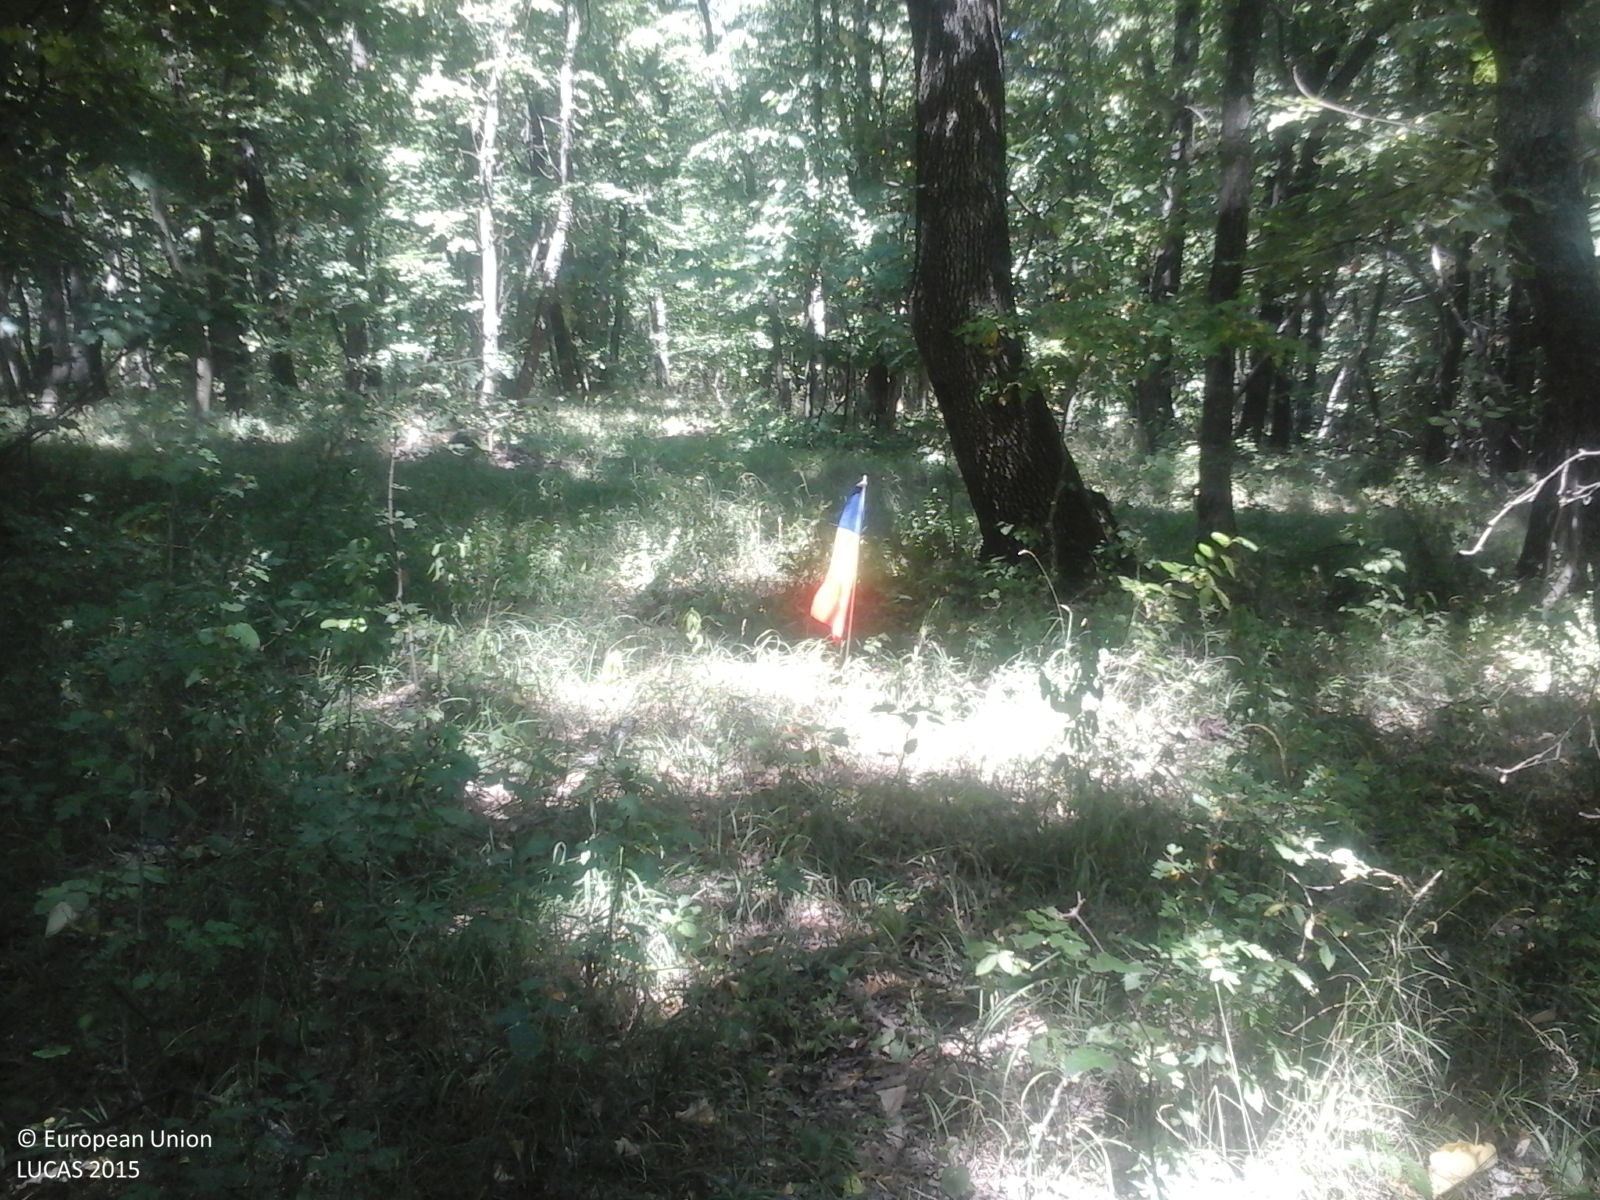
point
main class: Woodland
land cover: Broadleaved woodland
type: acidophilous oak and oak-birch forest
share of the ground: > 75 %
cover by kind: broadleaved forest trees 100 %
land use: Forestry
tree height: > 5 m
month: July
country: RO
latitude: 46.5096
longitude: 27.9670
